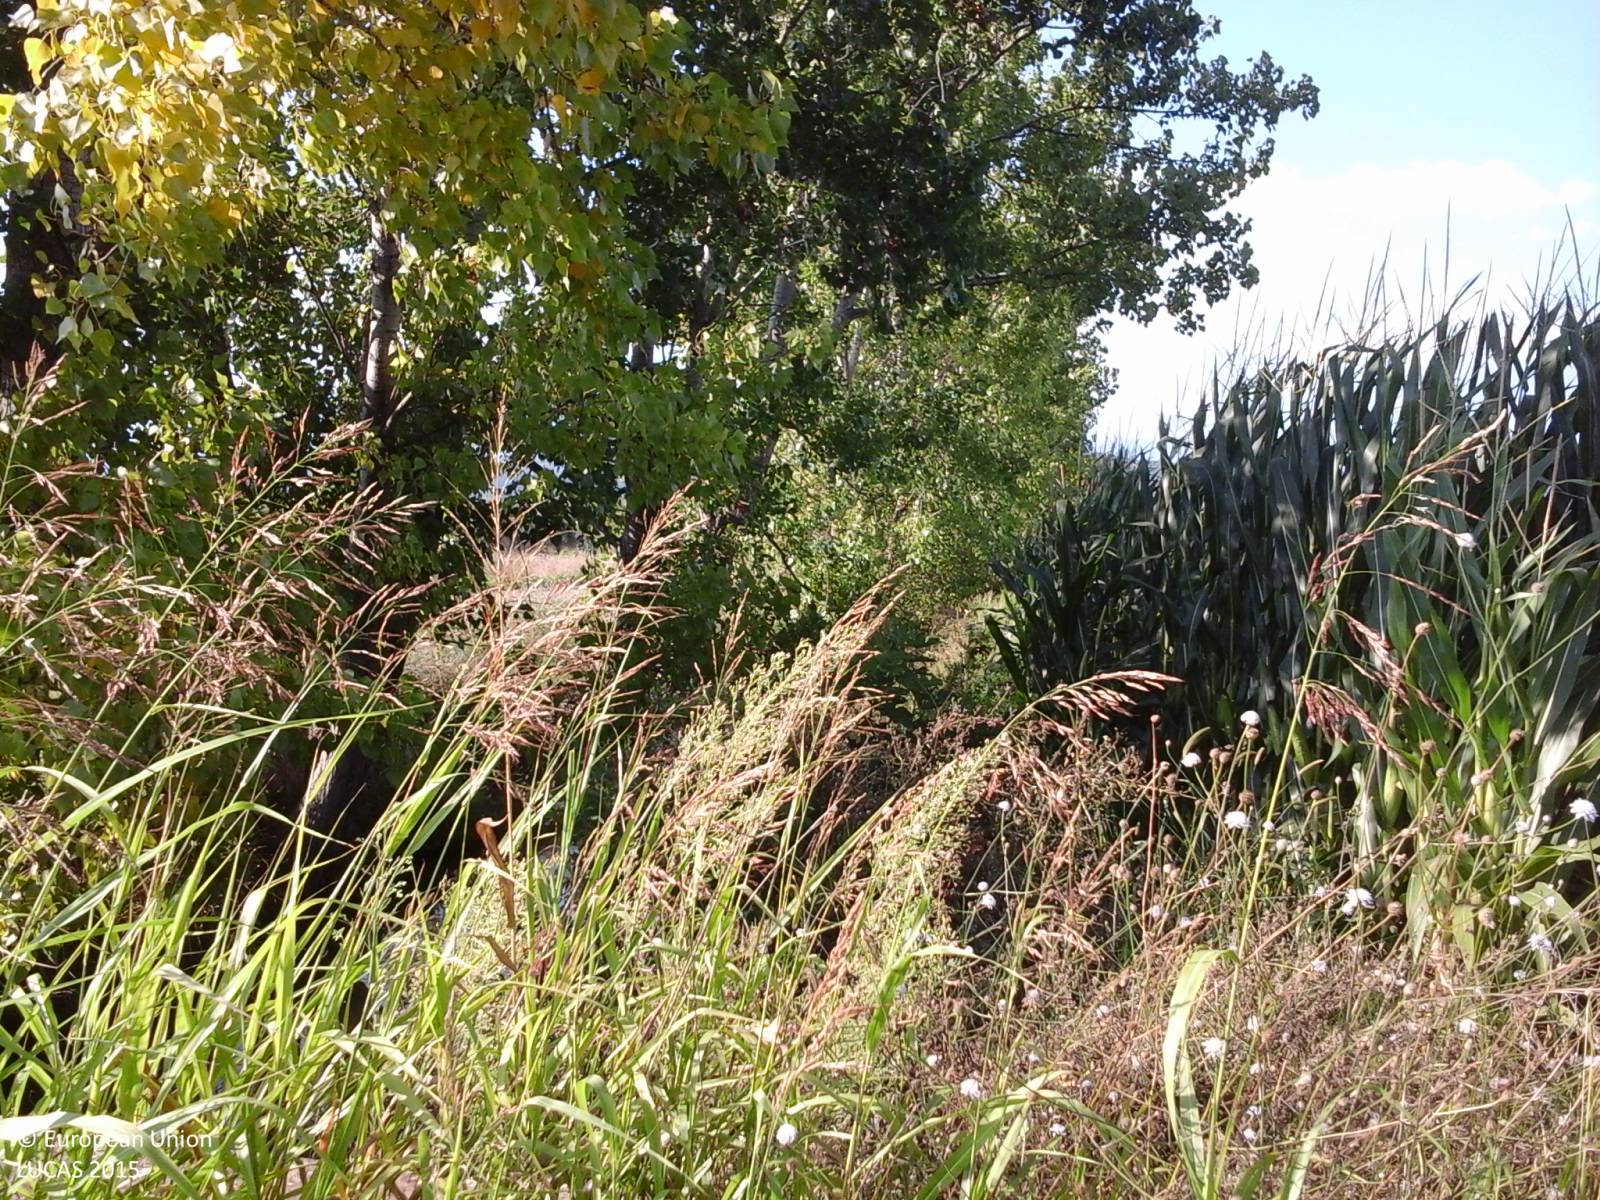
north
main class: Cropland
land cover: Maize
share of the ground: > 75 %
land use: Agriculture (excluding fallow land and kitchen gardens)
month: August
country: IT
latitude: 41.4113
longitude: 13.1576
